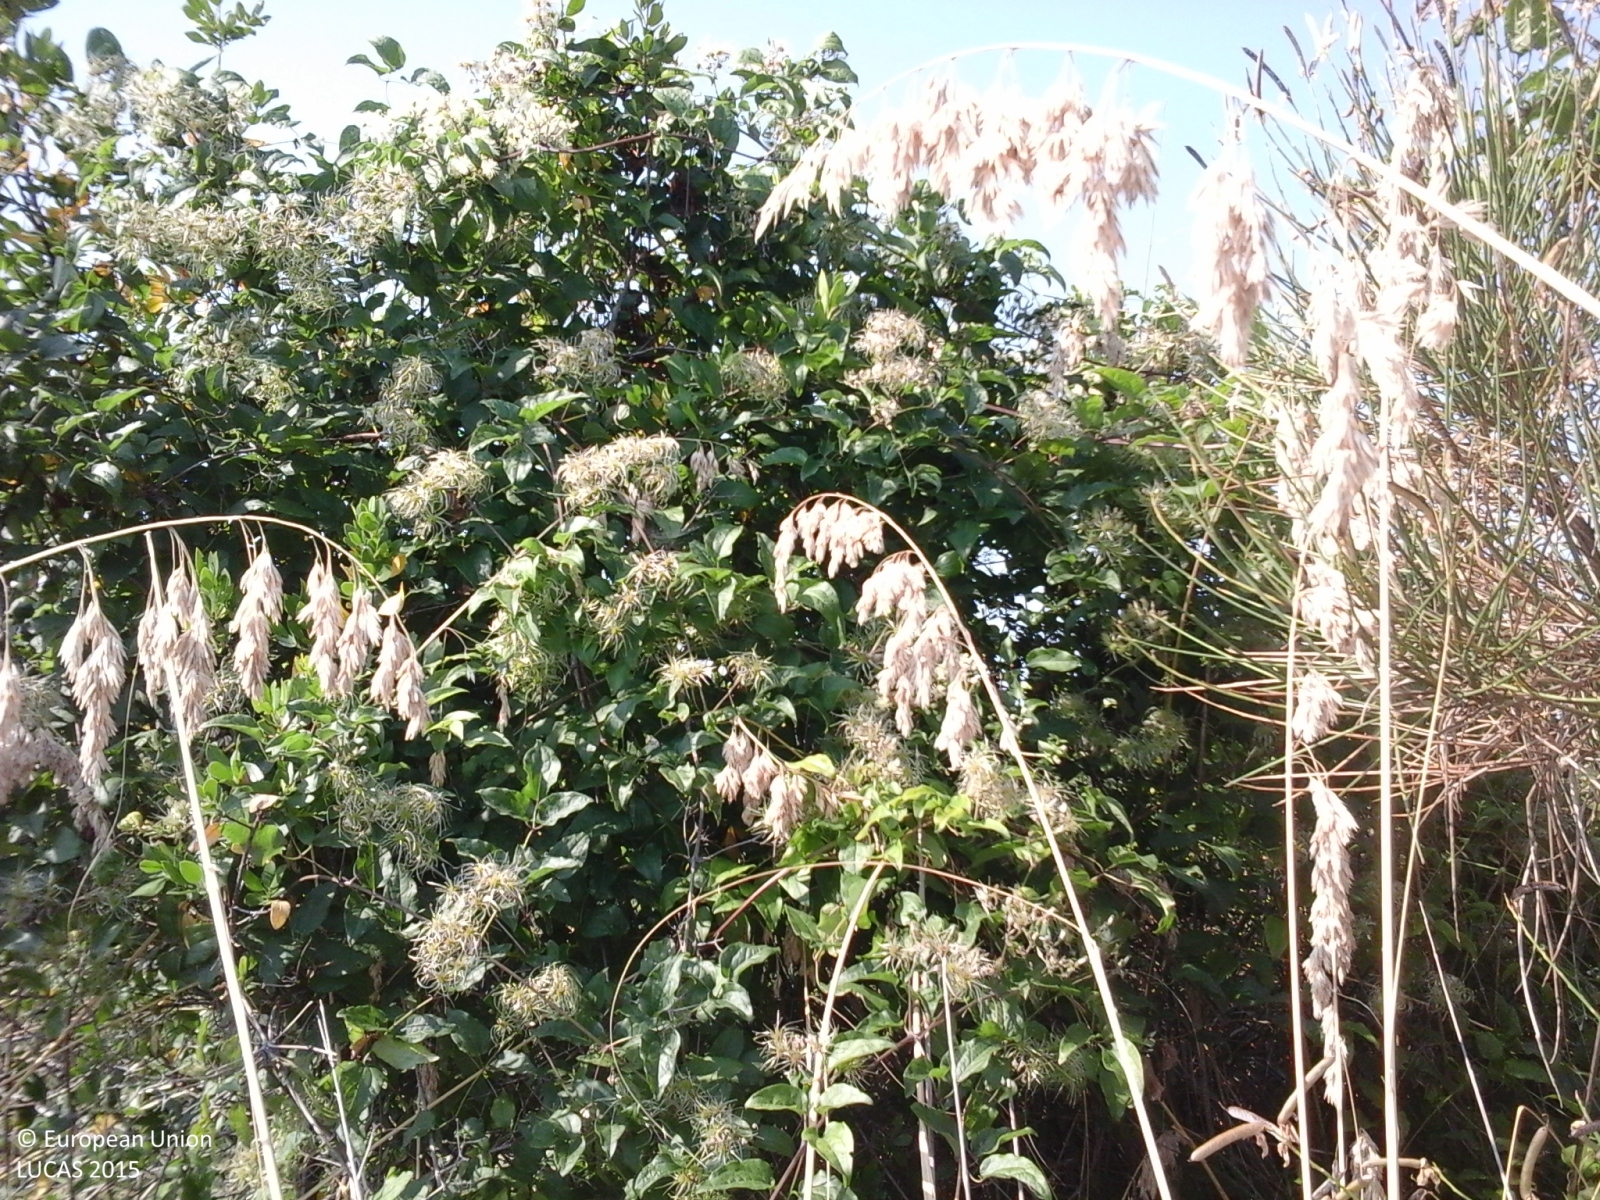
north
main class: Shrubland
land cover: Shrubland without tree cover
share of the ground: 50 - 75 %
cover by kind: shrubs 95 %, herbaceous plants 5 %
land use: Semi-natural and natural areas not in use
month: July
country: IT
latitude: 43.1065
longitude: 13.8116
